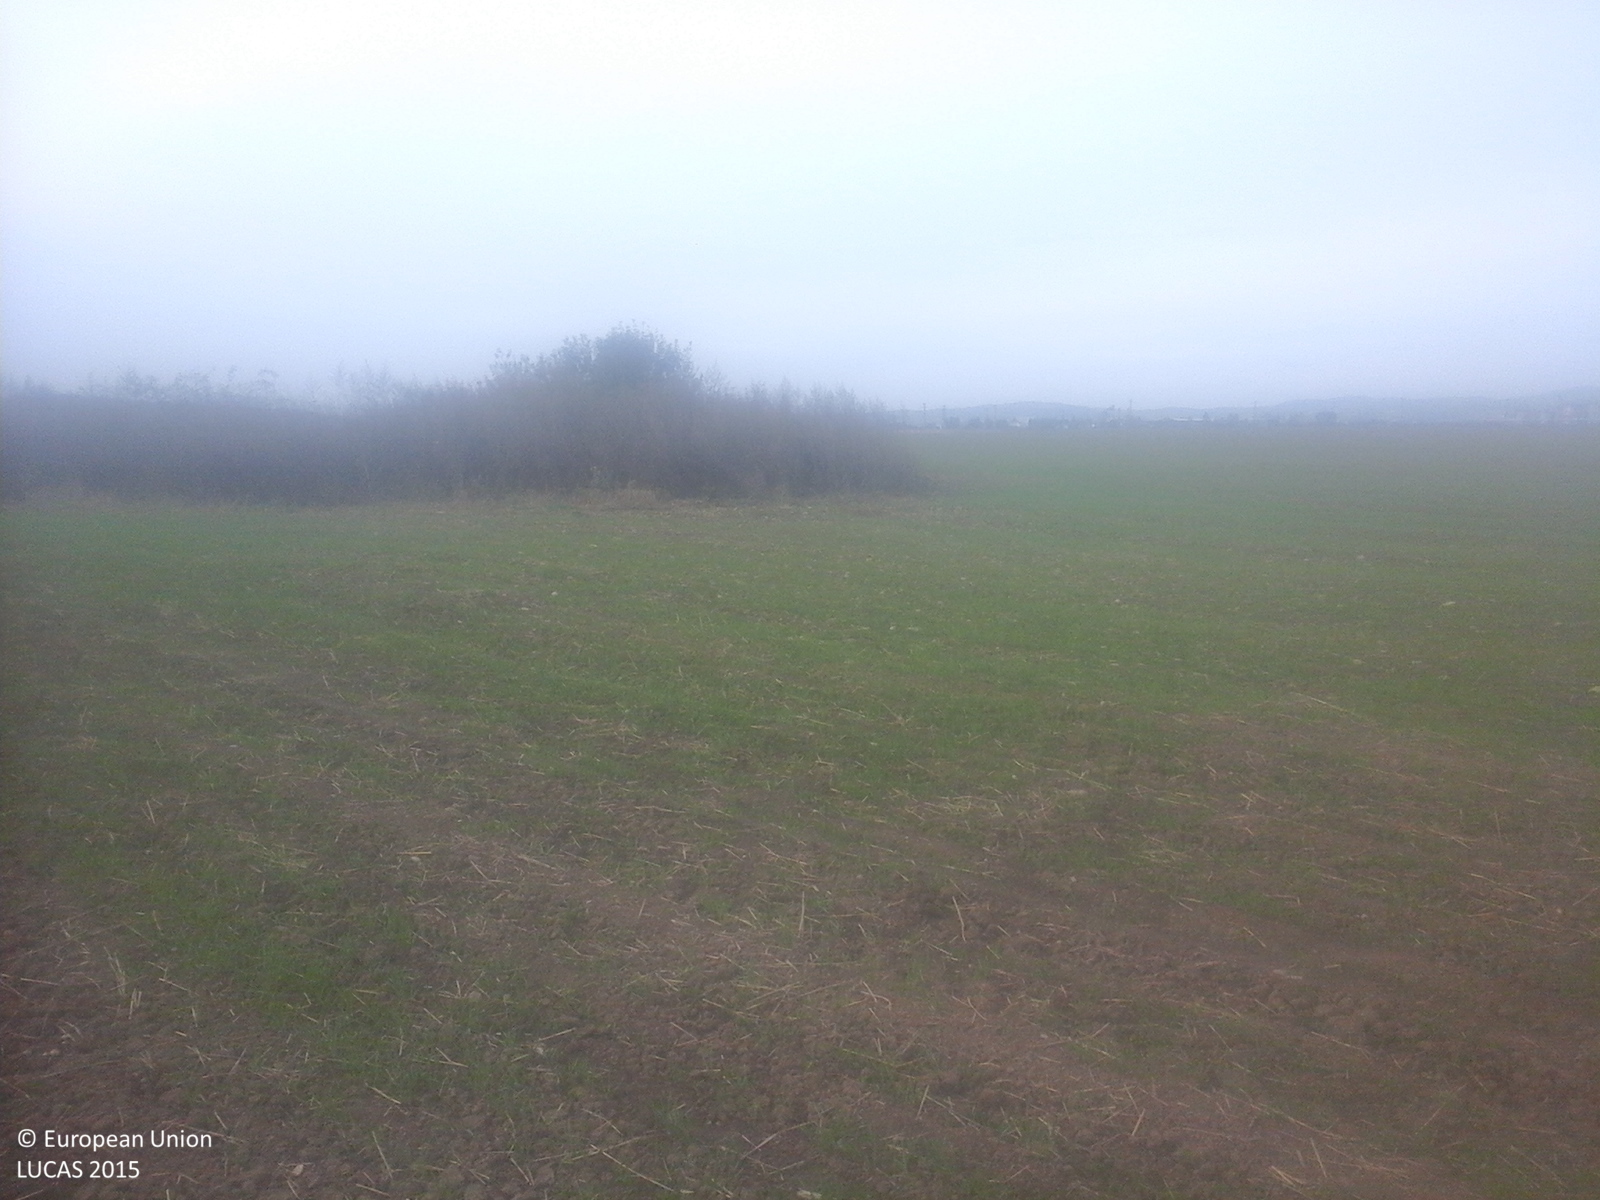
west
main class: Cropland
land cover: Common wheat
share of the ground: 10 - 25 %
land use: Agriculture (excluding fallow land and kitchen gardens)
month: October
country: RO
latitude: 44.9502
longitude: 25.7814
